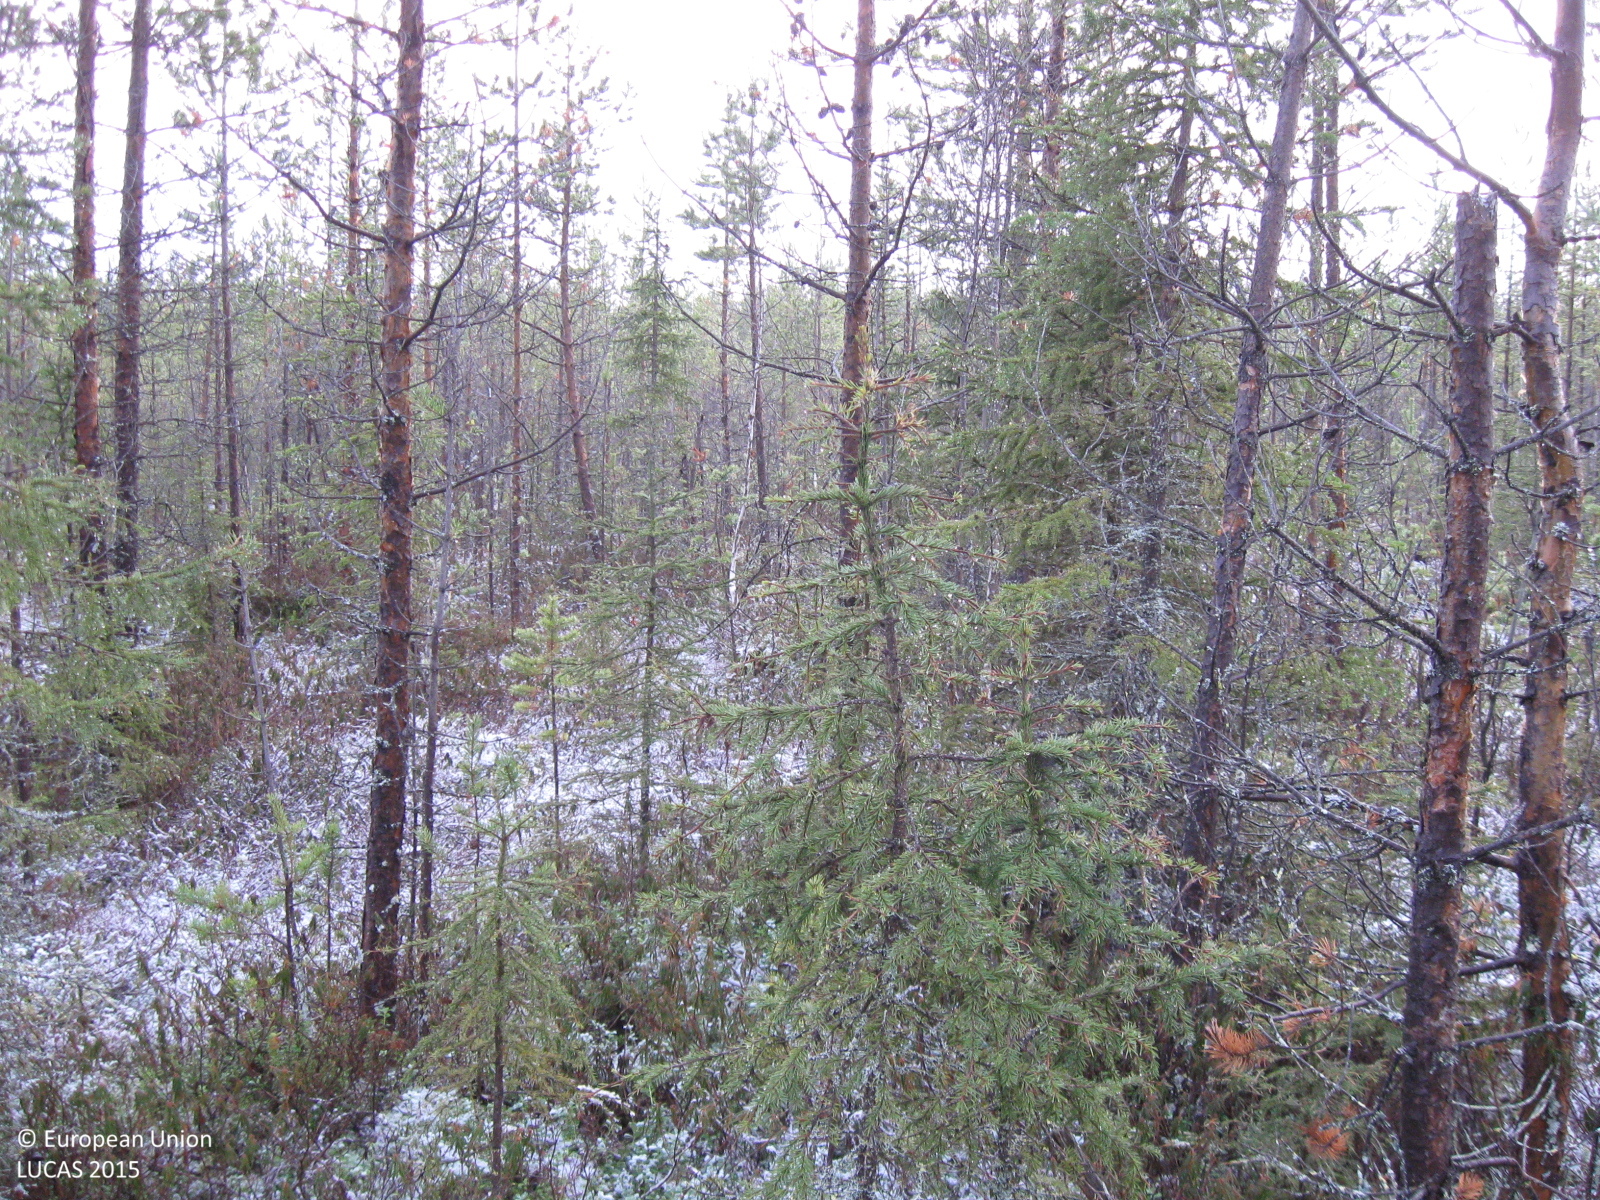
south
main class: Woodland
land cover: Other mixed woodland
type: boreal forest
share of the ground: > 75 %
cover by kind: coniferous forest trees 55 %, broadleaved forest trees 20 %, shrubs 10 %, lichens and mosses 10 %, herbaceous plants 5 %
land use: Forestry
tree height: < 5 m
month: October
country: SE
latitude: 66.3150
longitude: 20.7795
